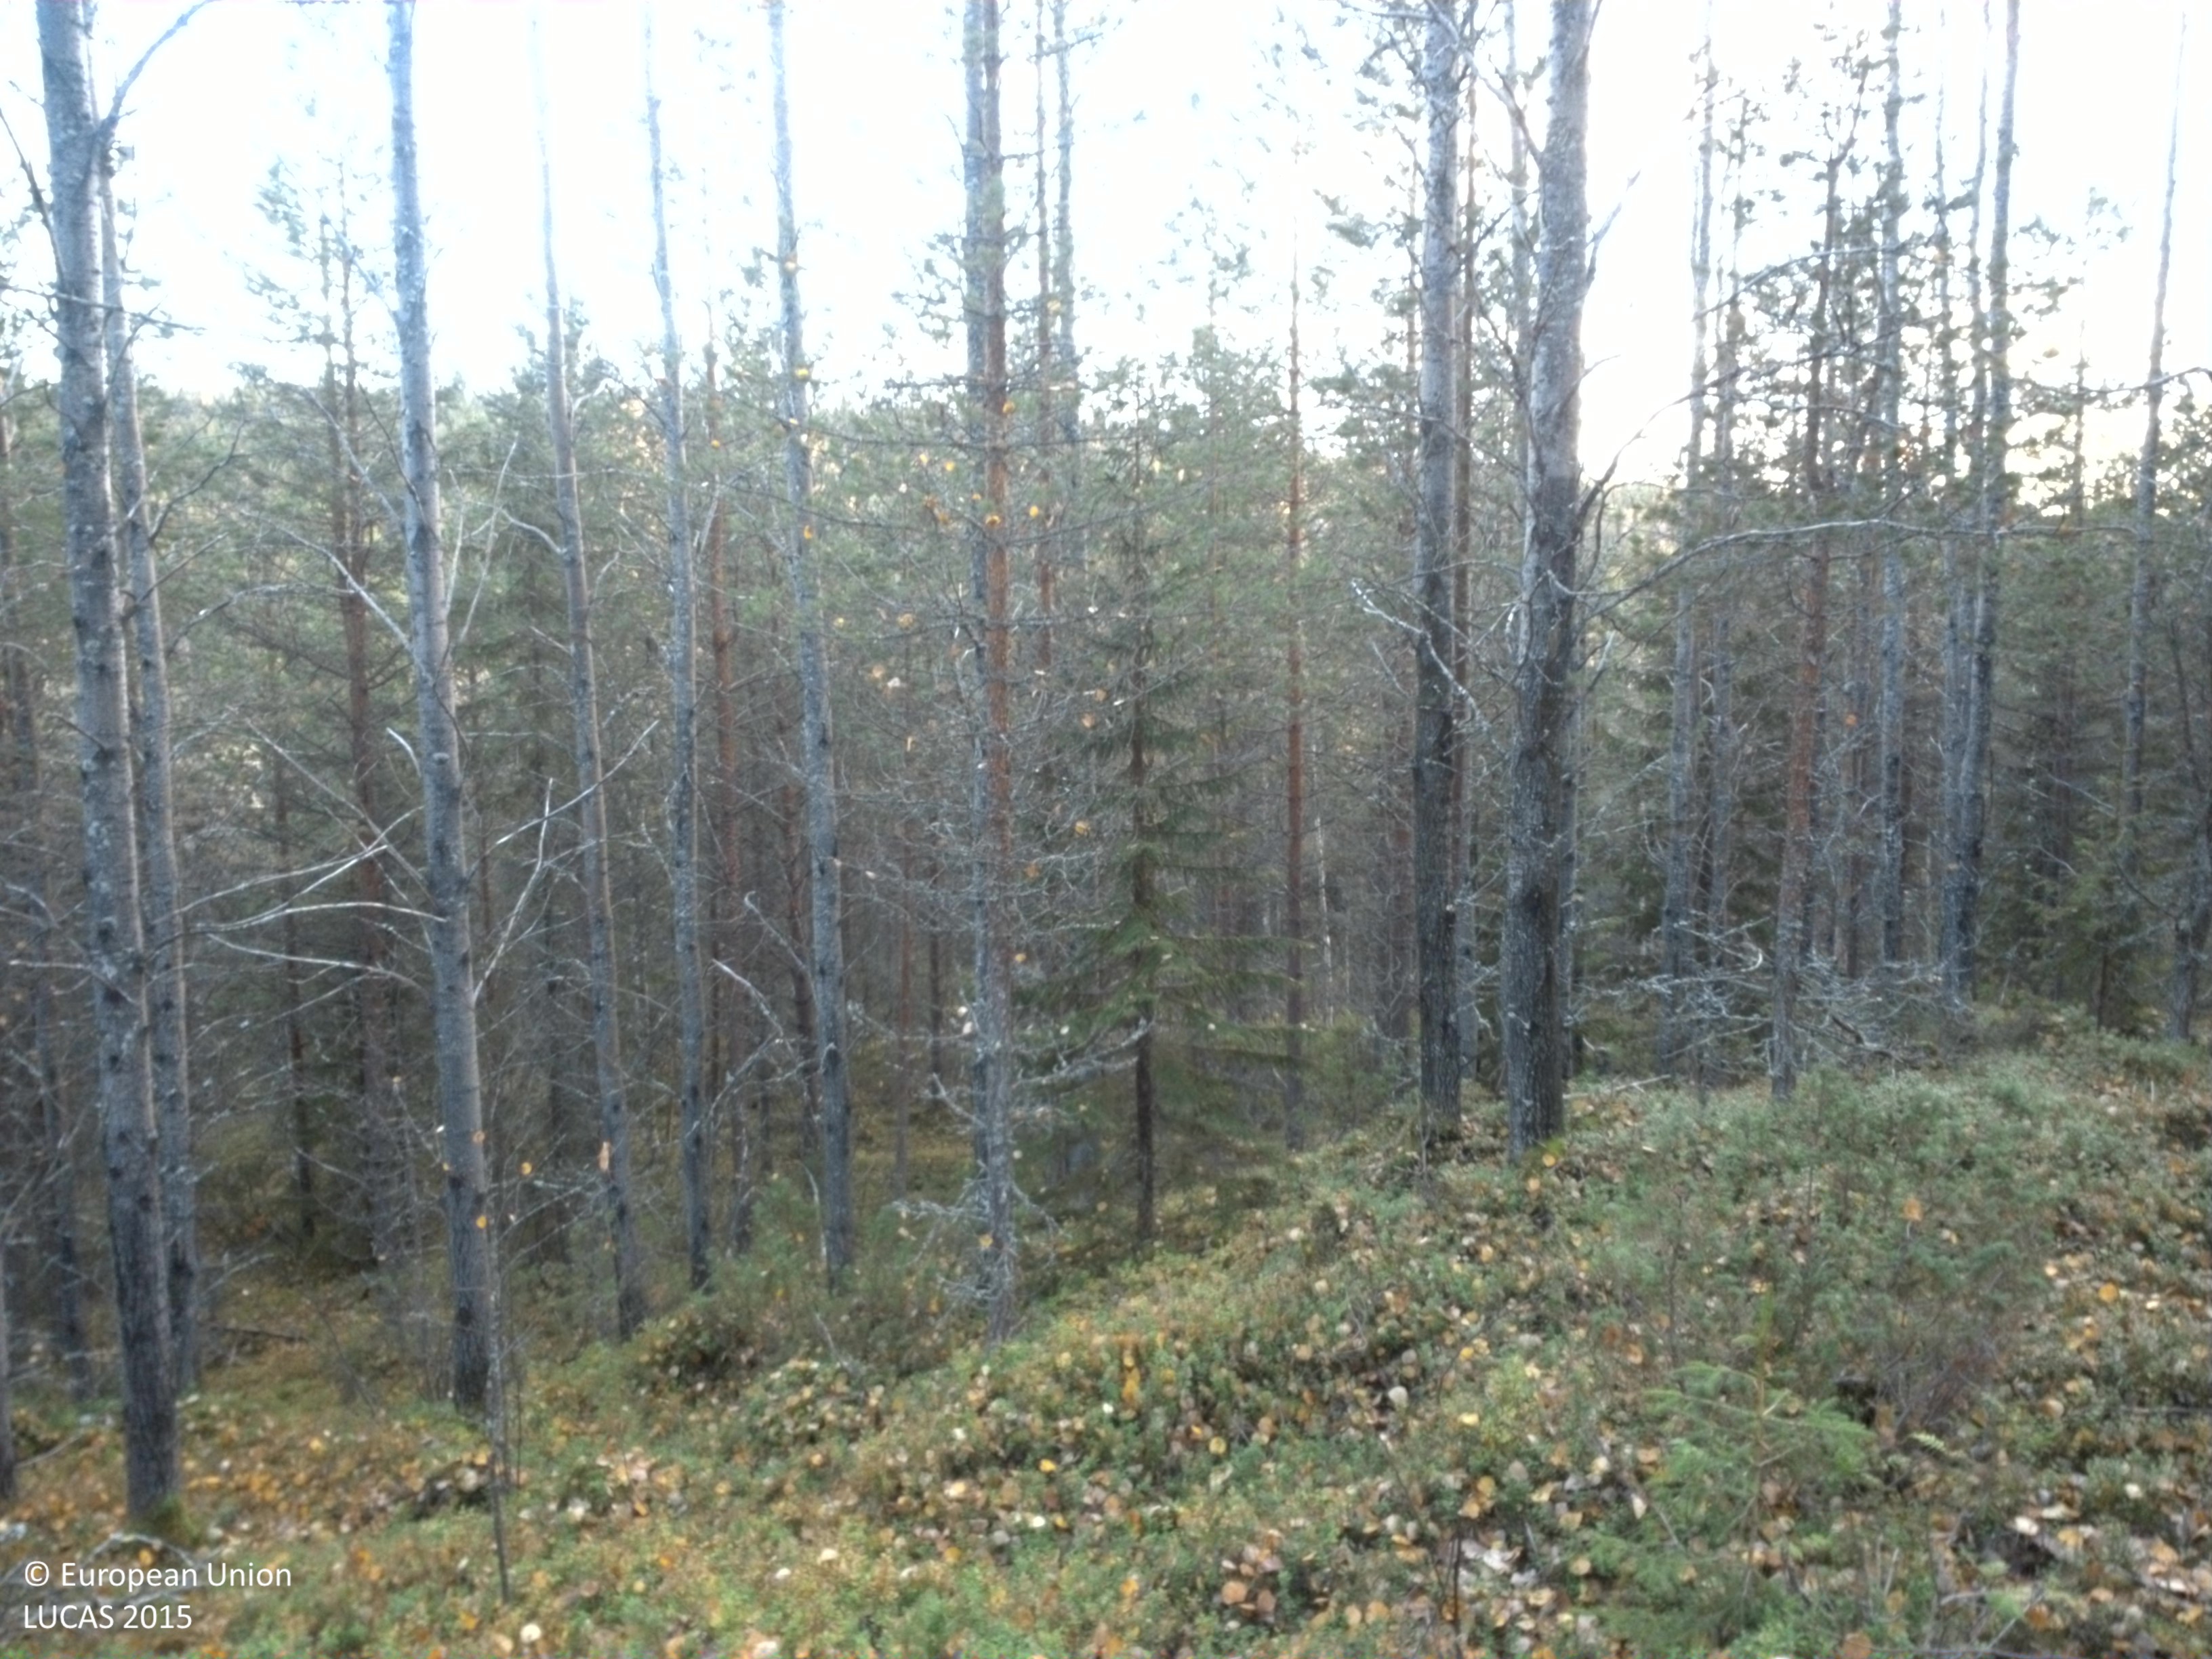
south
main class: Woodland
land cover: Pine dominated mixed woodland
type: boreal forest
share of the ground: 25 - 50 %
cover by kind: shrubs 45 %, coniferous forest trees 20 %, broadleaved forest trees 20 %, herbaceous plants 5 %, lichens and mosses 5 %, unconsolidated bare surface 5 %
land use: Forestry
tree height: > 5 m
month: October
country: SE
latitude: 64.6060
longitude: 17.0097
